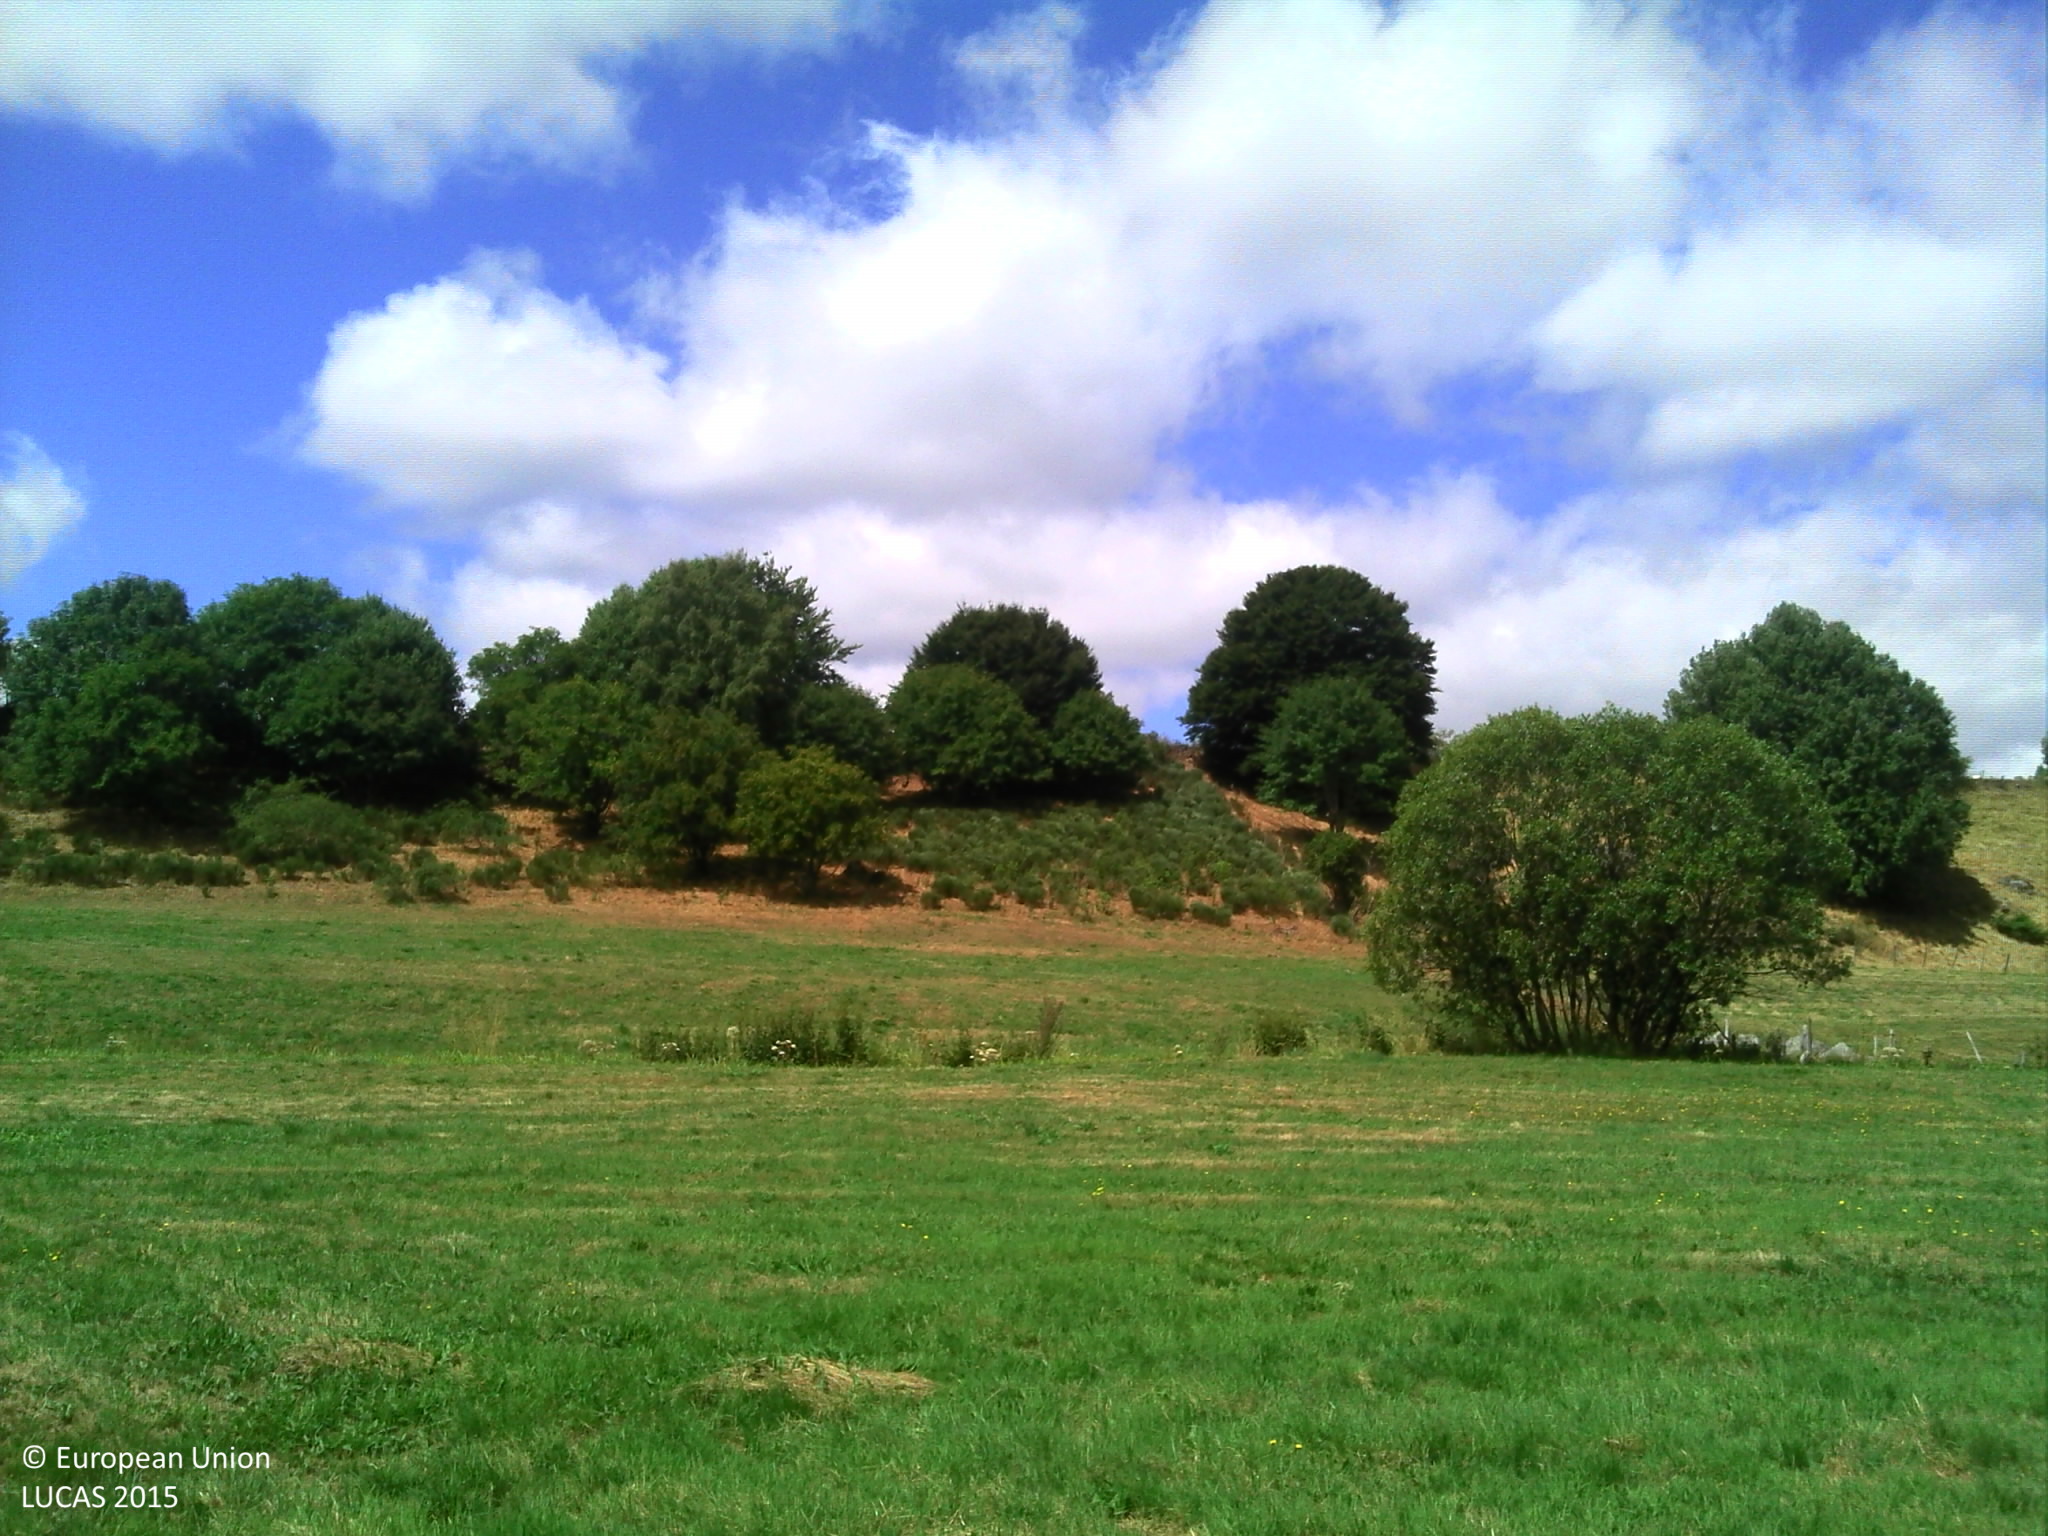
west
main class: Grassland
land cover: Grassland without tree/shrub cover
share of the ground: > 75 %
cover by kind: herbaceous plants 100 %
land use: Agriculture (excluding fallow land and kitchen gardens)
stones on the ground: 10 - 25 %
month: July
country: FR
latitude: 44.8122
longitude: 3.4414
